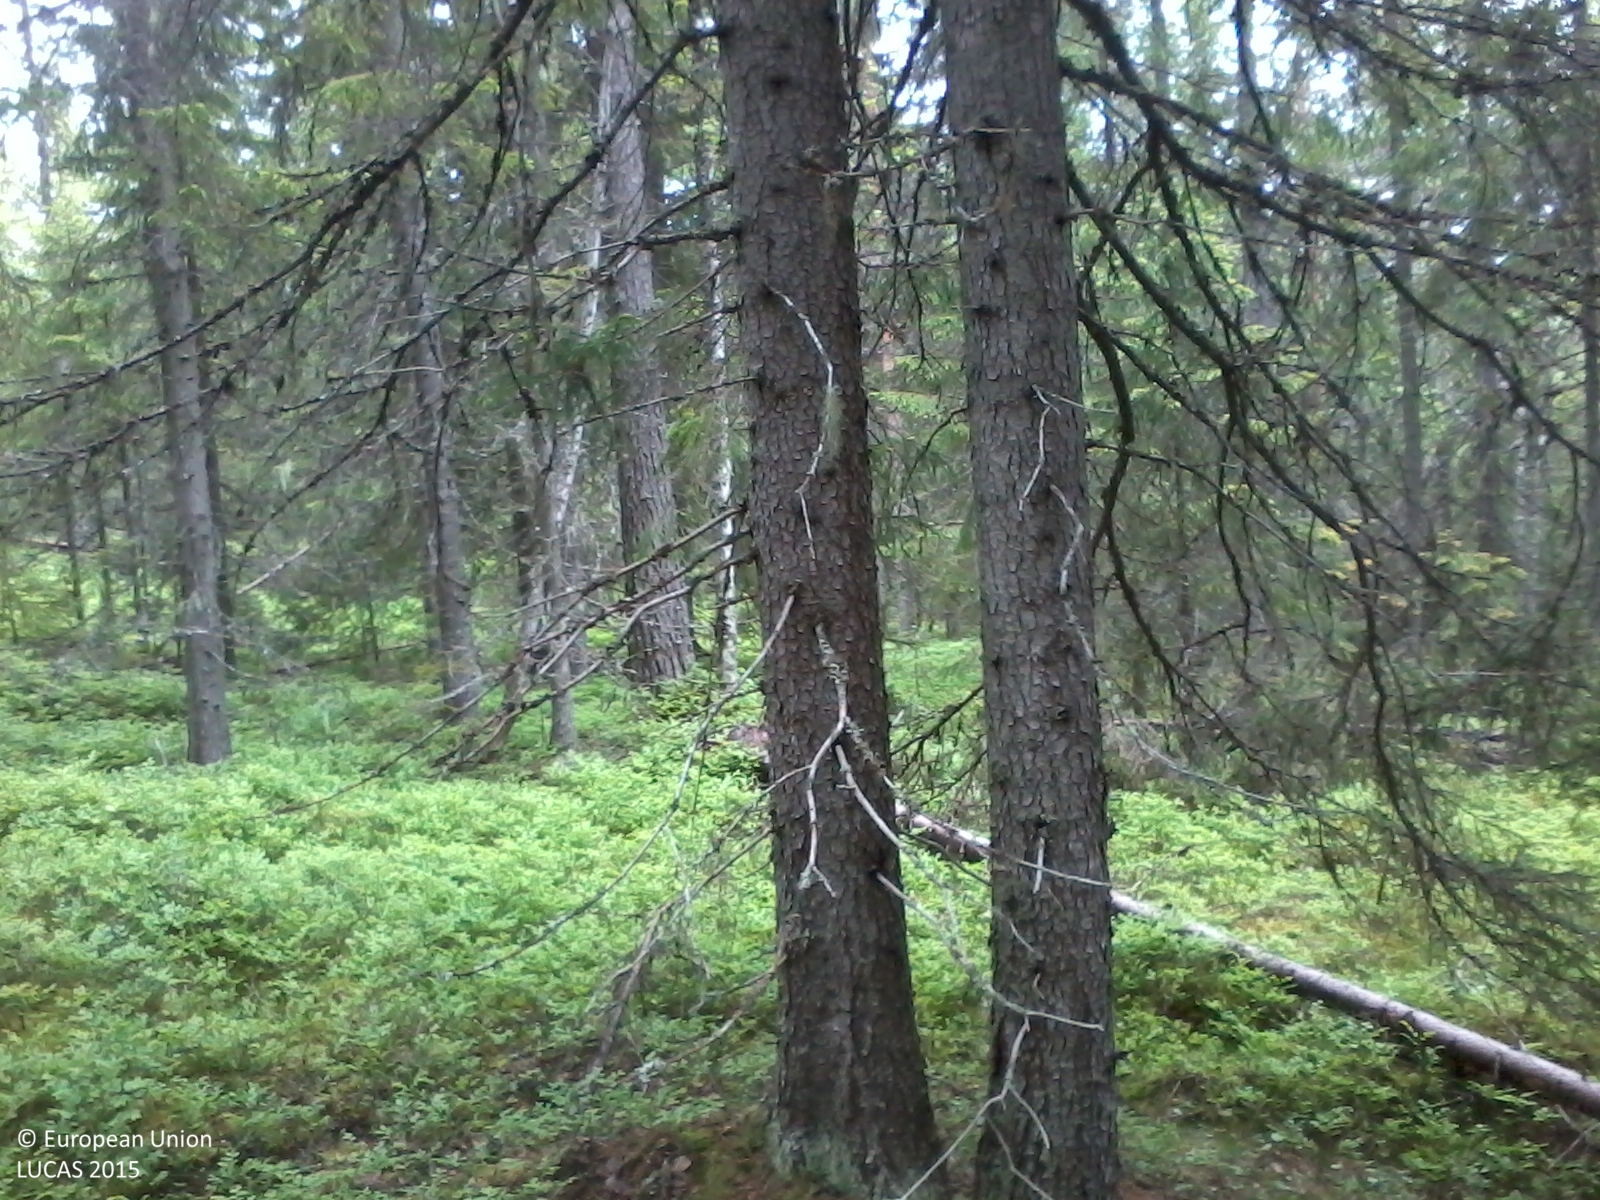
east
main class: Woodland
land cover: Spruce dominated coniferous woodland
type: boreal forest
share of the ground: 50 - 75 %
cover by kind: coniferous forest trees 60 %, shrubs 35 %, broadleaved forest trees 5 %
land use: Forestry
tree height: > 5 m
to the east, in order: Spruce dominated coniferous woodland; Pine dominated coniferous woodland; Spruce dominated coniferous woodland; Spruce dominated mixed woodland; Tracks
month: June
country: SE
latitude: 63.4888
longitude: 17.9867
